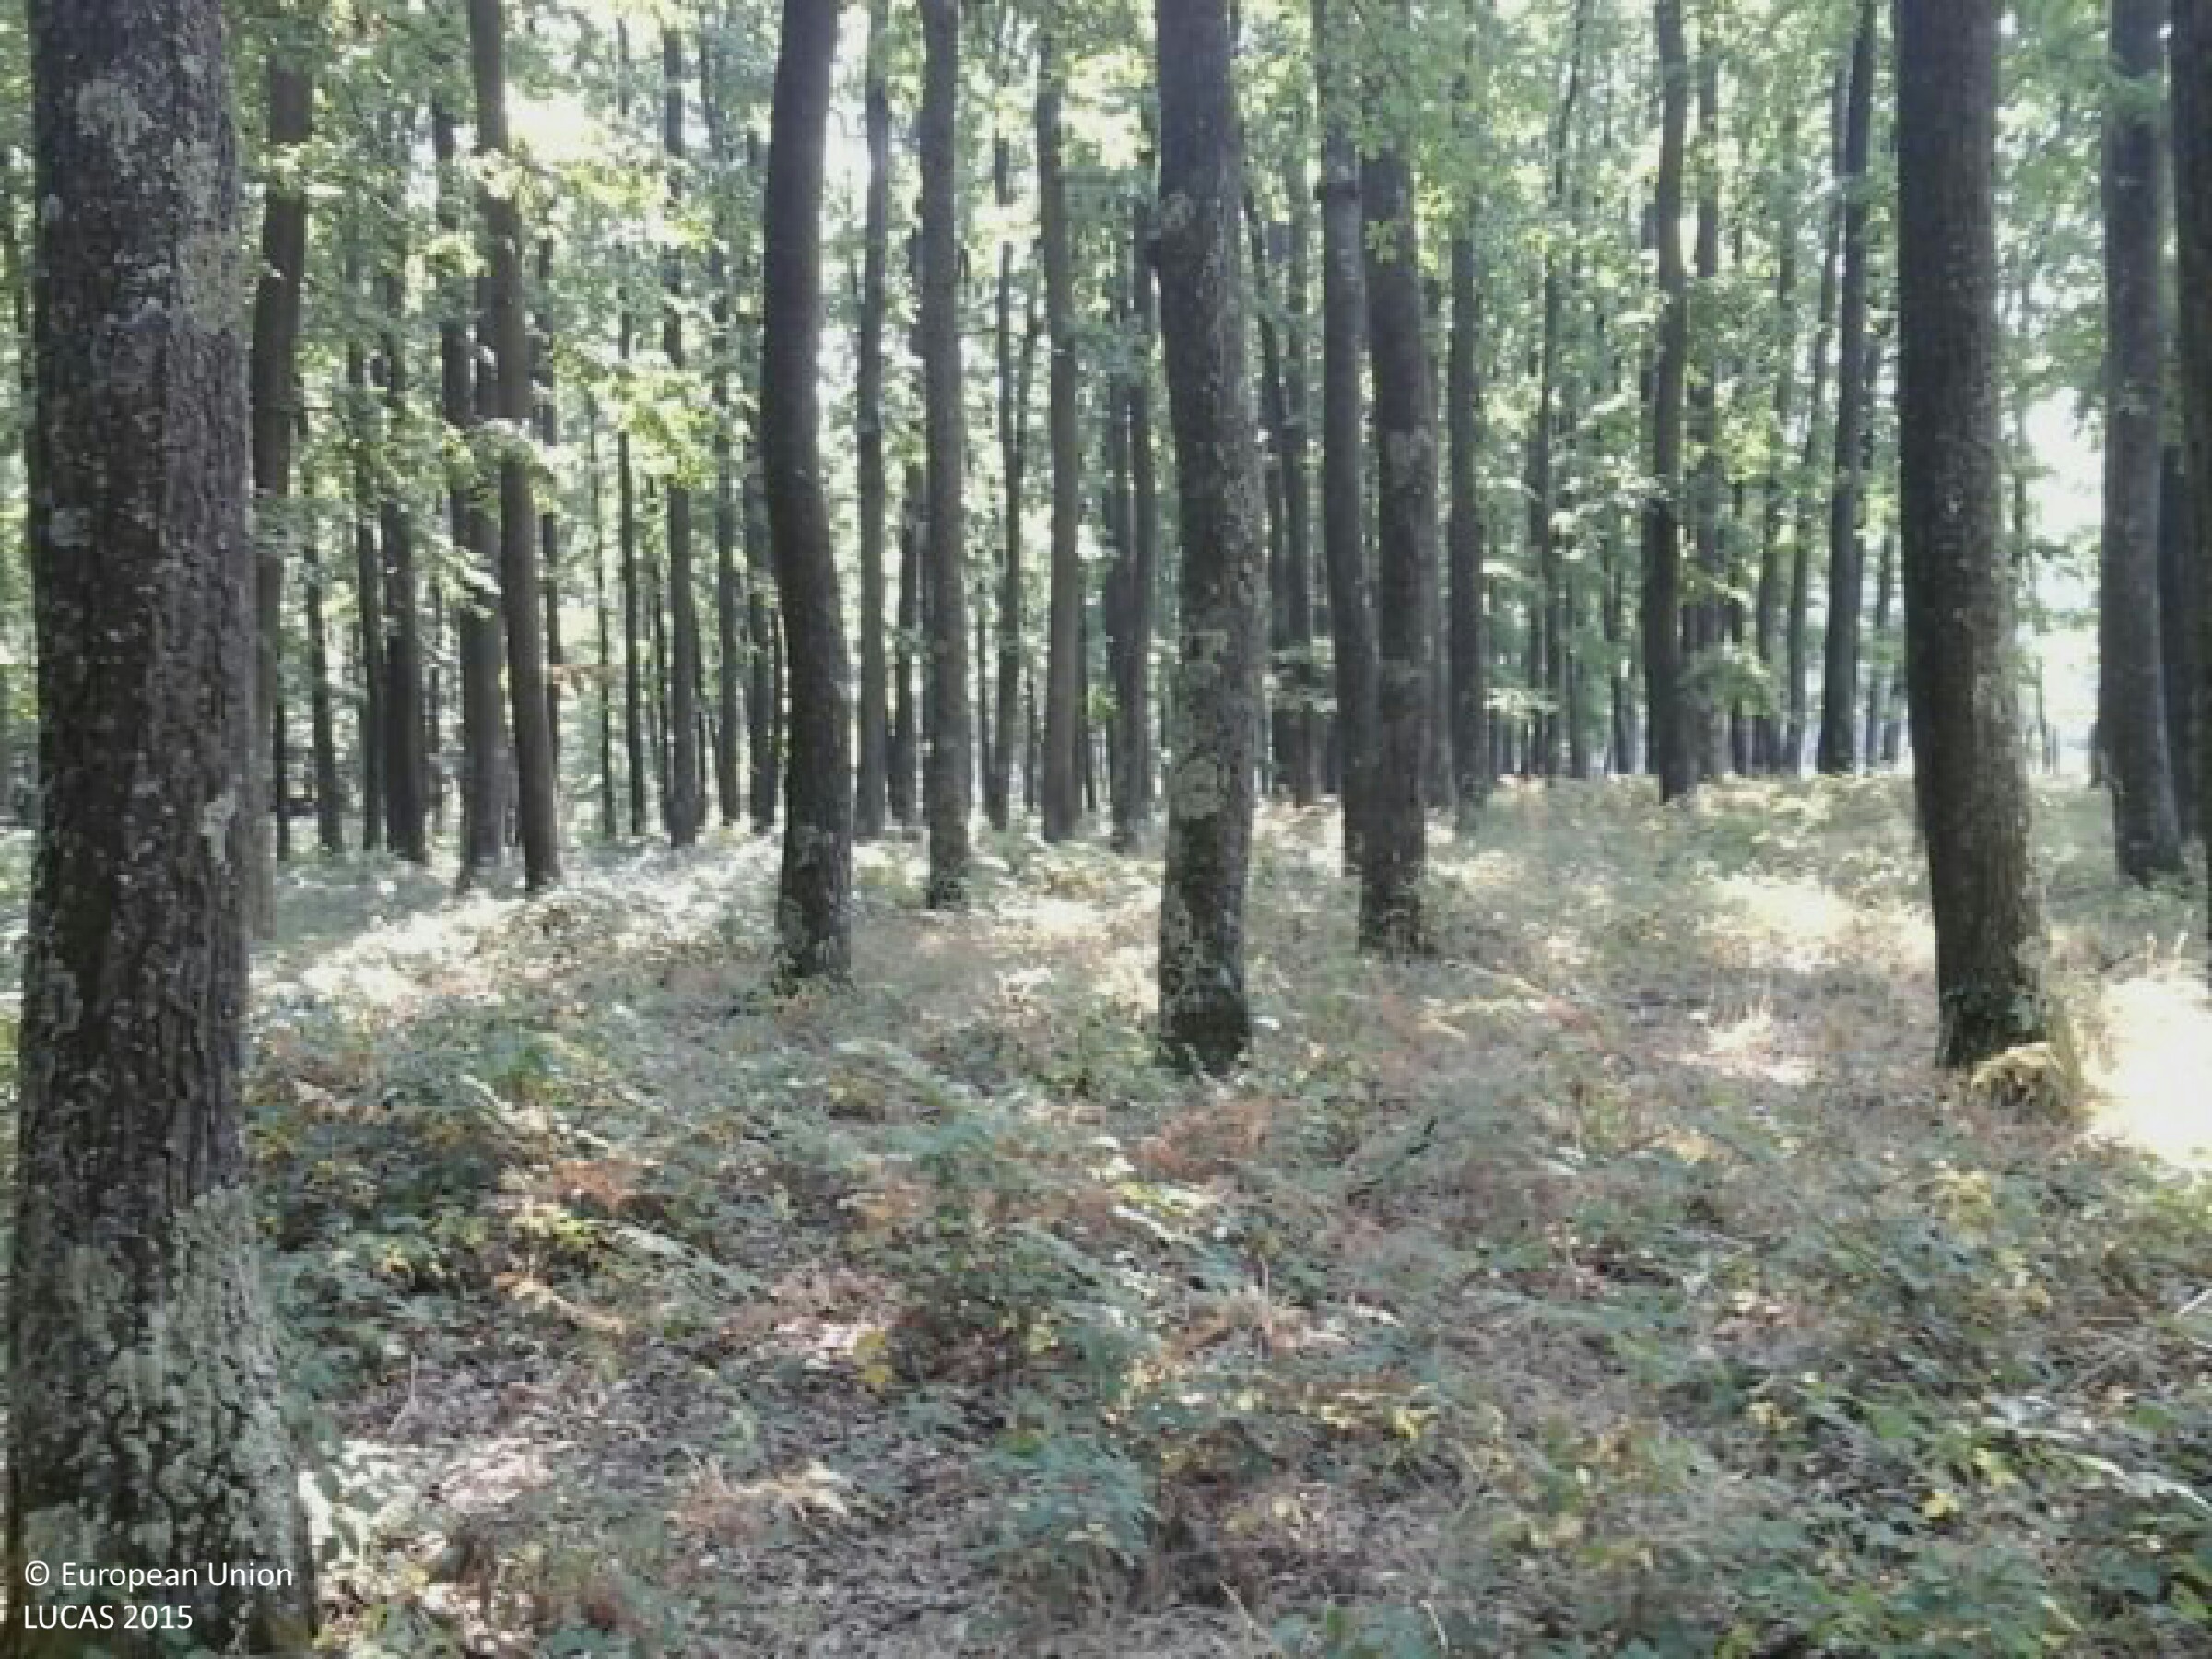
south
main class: Woodland
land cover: Broadleaved woodland
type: mesophytic deciduous forest
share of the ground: > 75 %
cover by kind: broadleaved forest trees 95 %, shrubs 5 %
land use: Forestry
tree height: > 5 m
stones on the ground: < 10 %
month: August
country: HU
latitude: 46.1957
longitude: 17.2465
